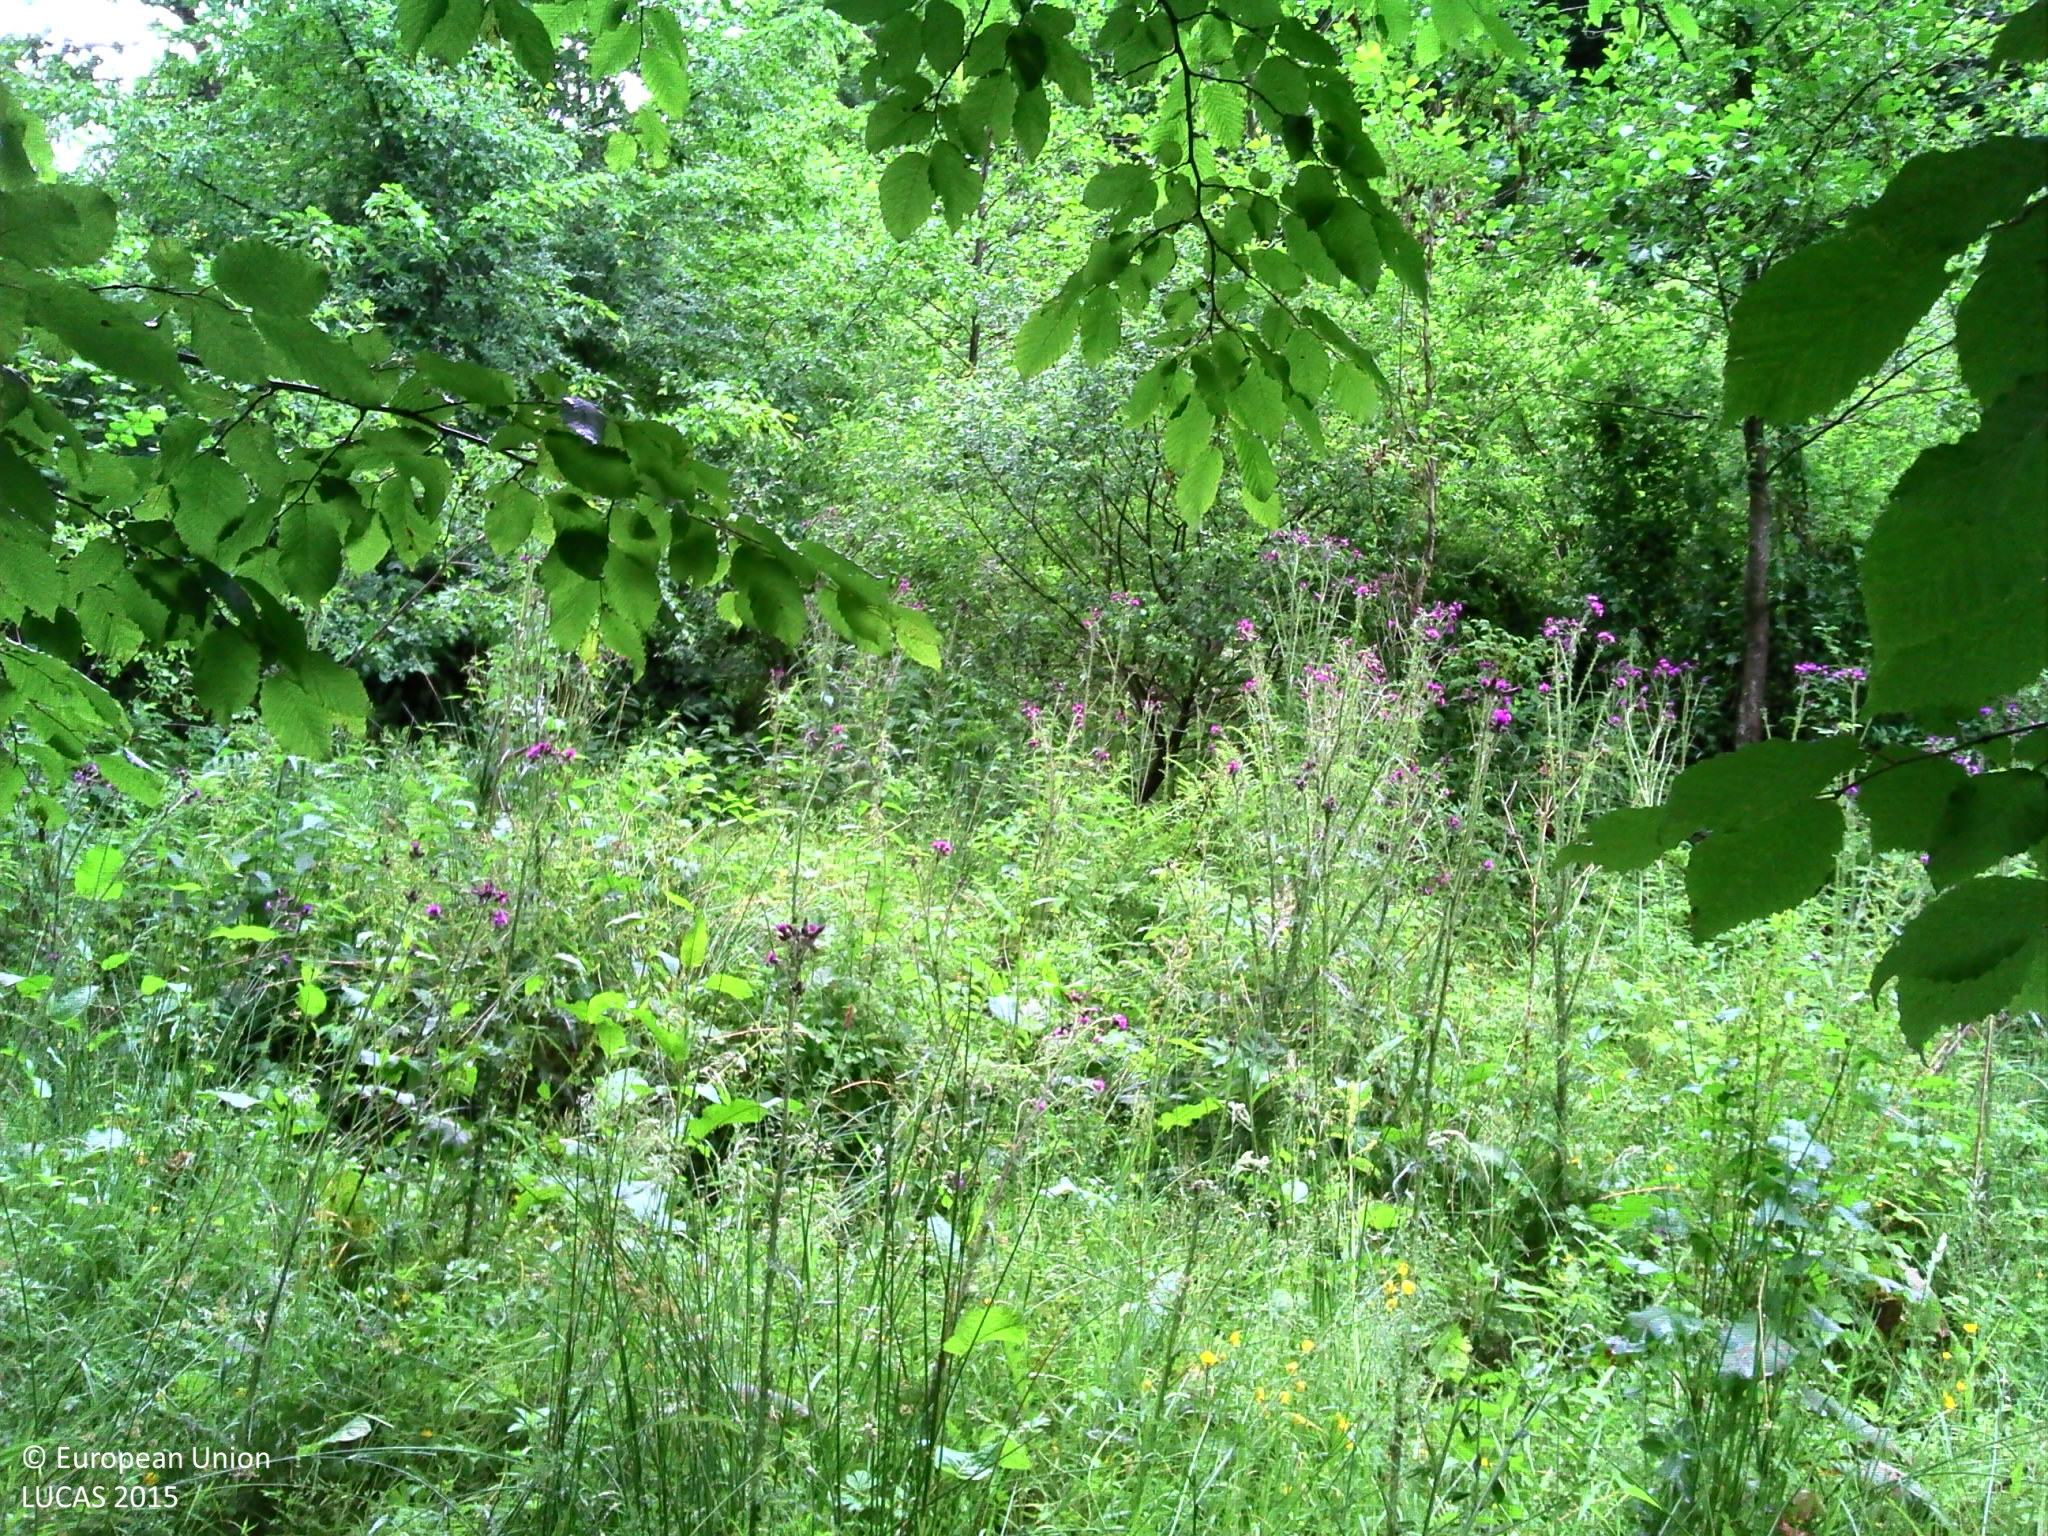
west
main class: Woodland
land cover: Broadleaved woodland
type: mesophytic deciduous forest
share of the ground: 50 - 75 %
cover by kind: broadleaved forest trees 60 %, shrubs 40 %
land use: Forestry
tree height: > 5 m
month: June
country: BE
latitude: 50.1677
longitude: 5.5043
